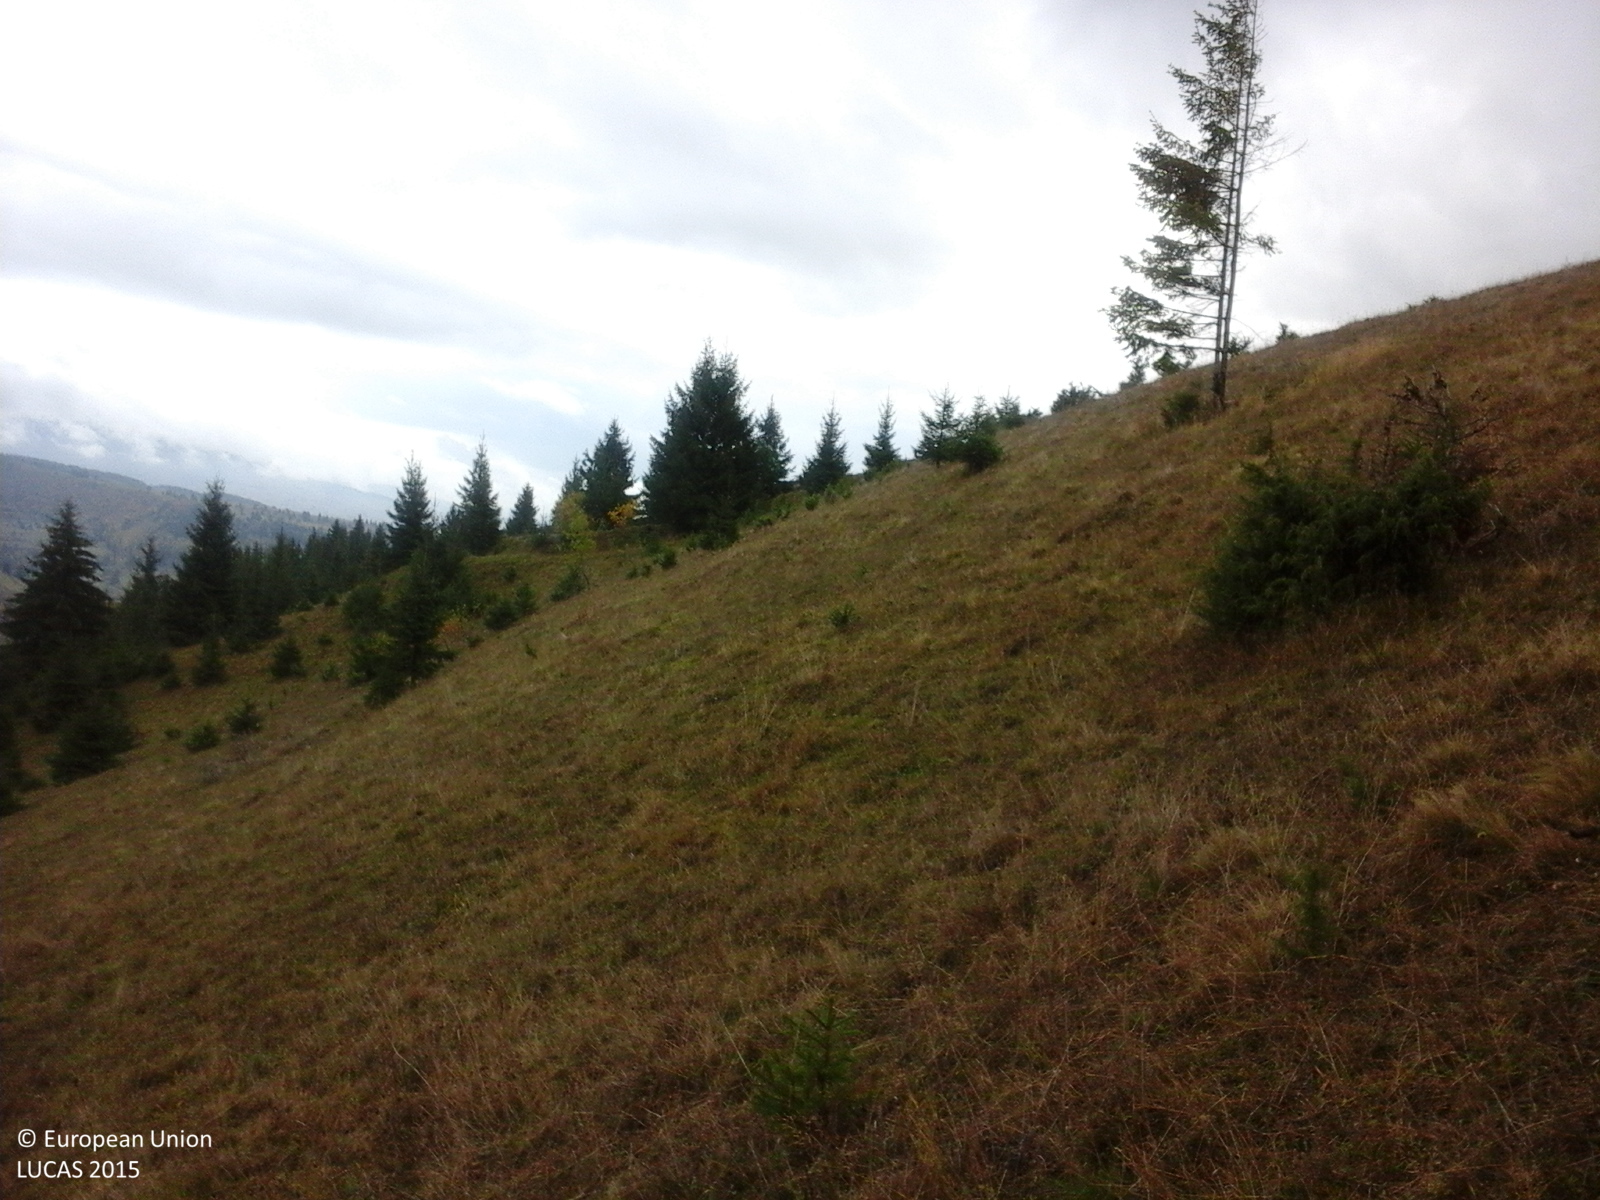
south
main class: Grassland
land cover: Grassland with sparse tree/shrub cover
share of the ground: > 75 %
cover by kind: herbaceous plants 95 %, coniferous forest trees 5 %
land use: Agriculture (excluding fallow land and kitchen gardens)
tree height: > 5 m
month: October
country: RO
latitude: 46.8798
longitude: 25.5036
